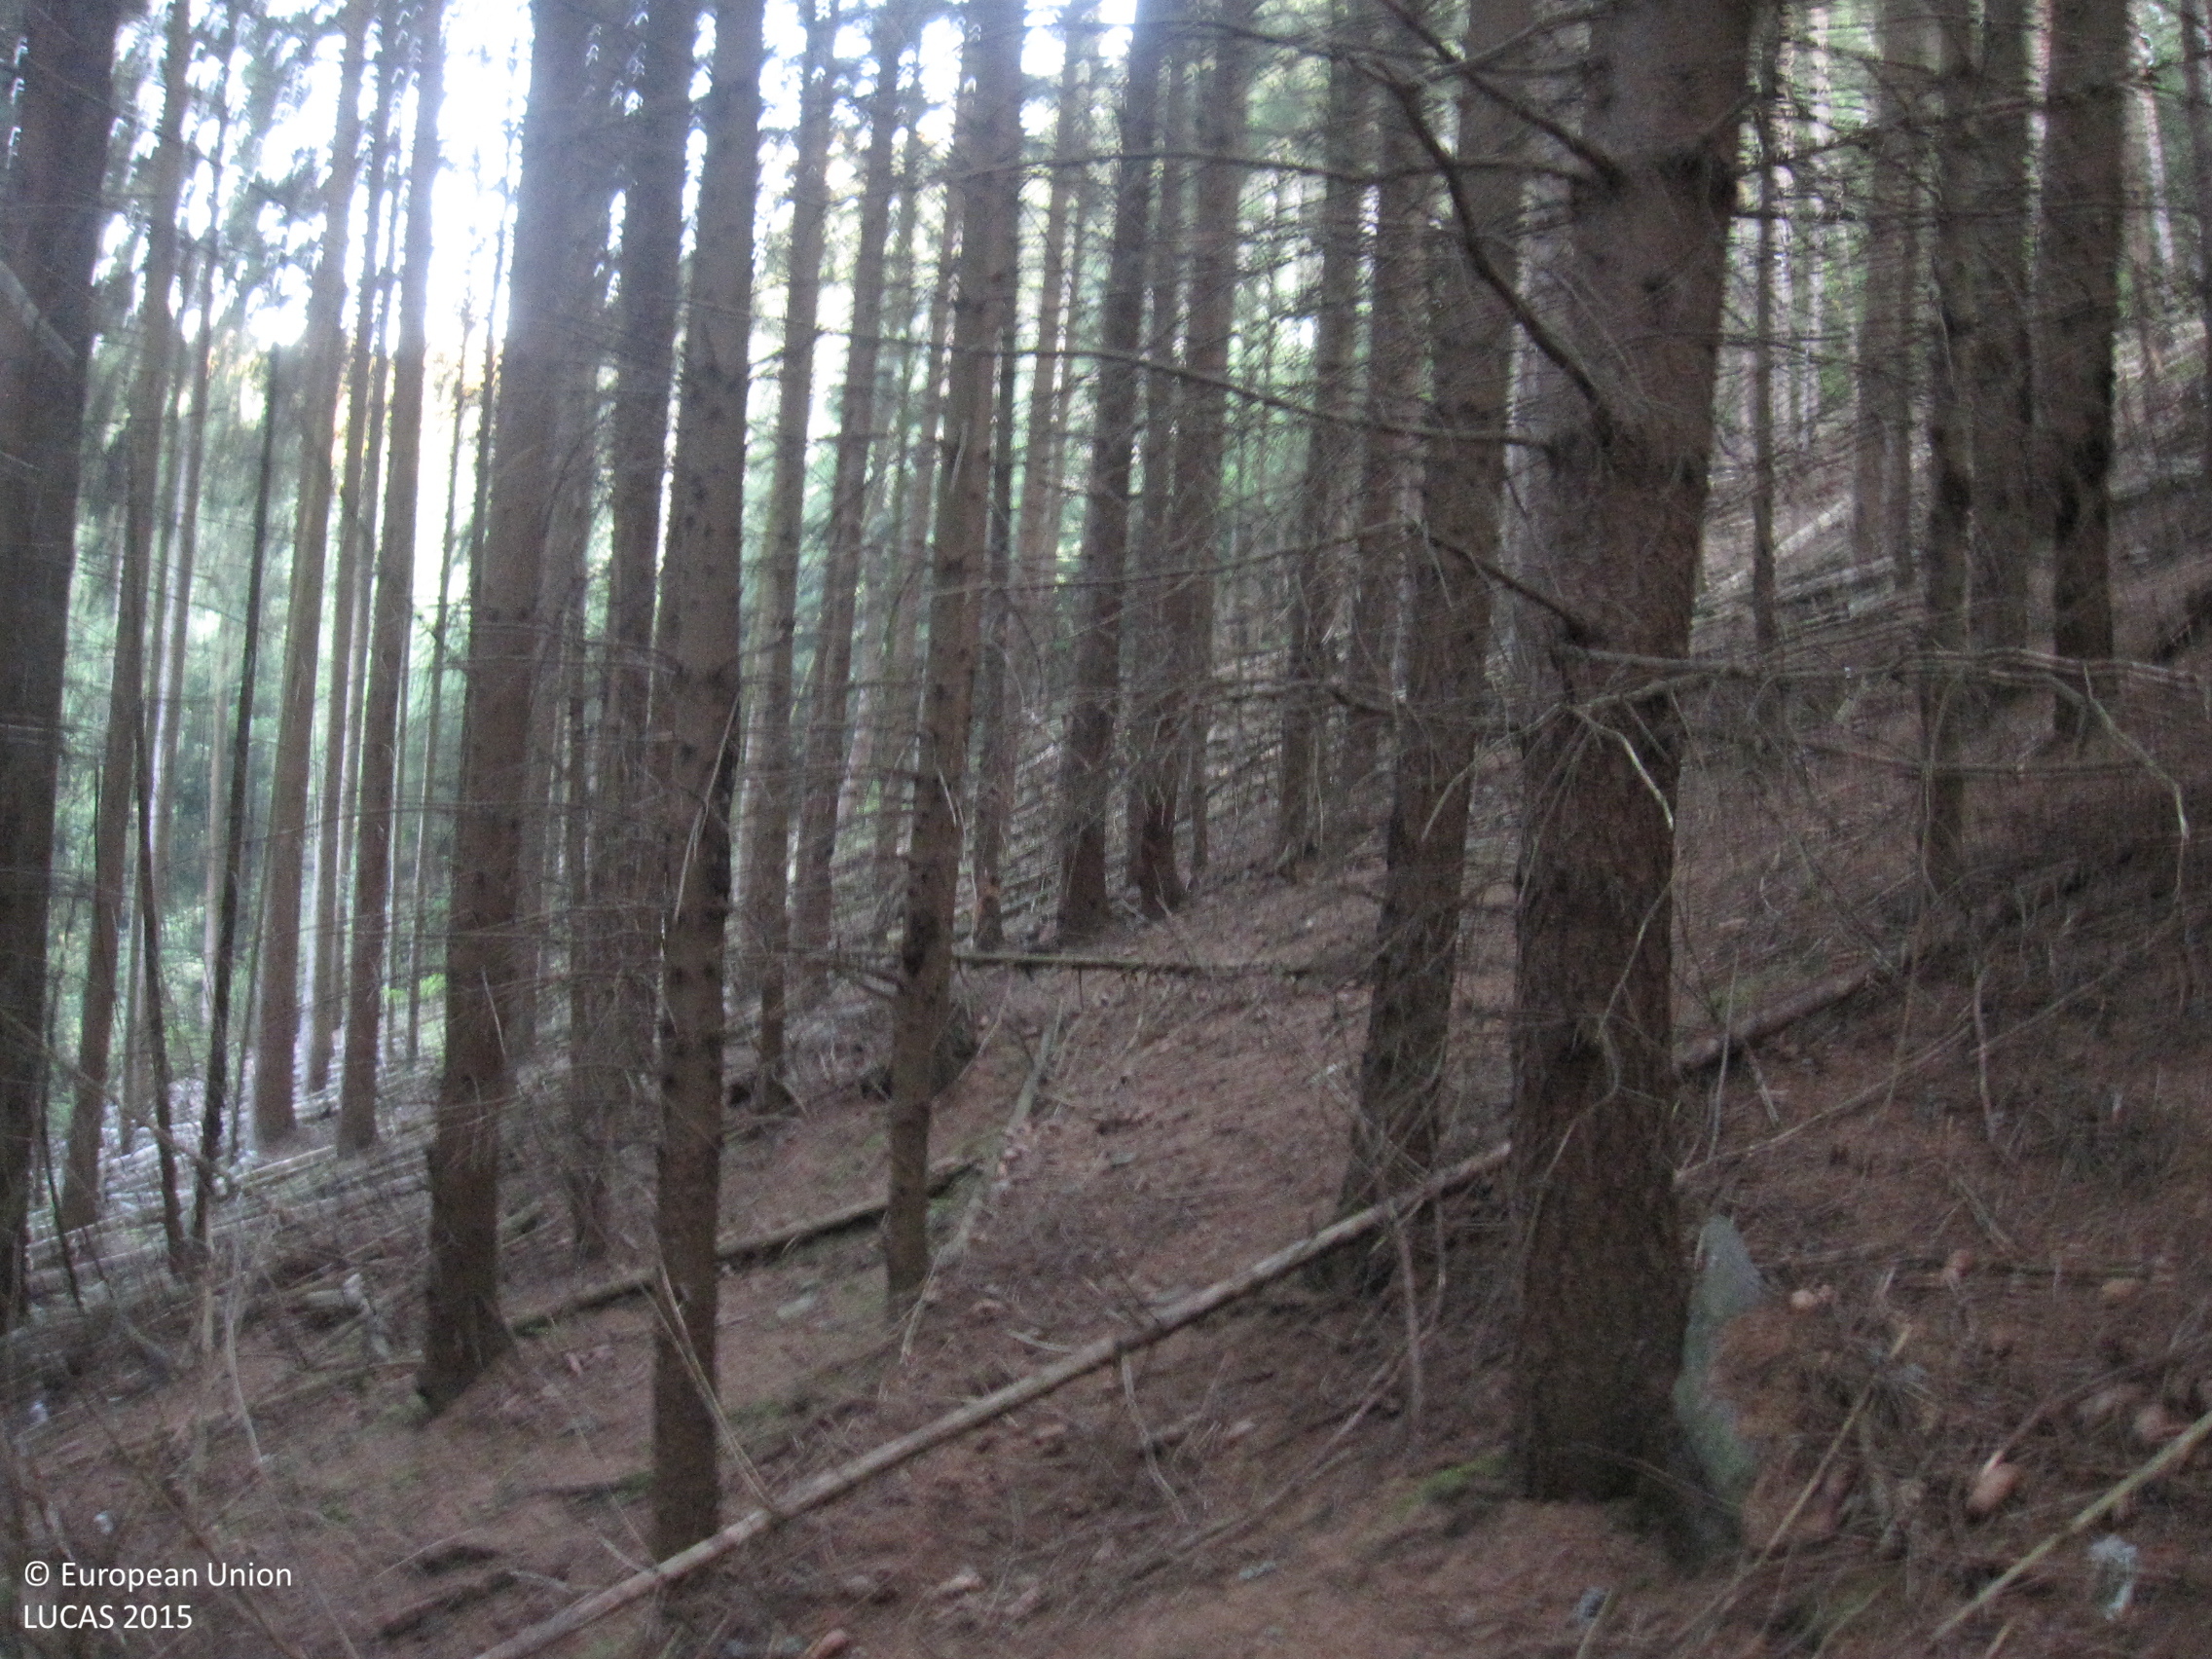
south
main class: Woodland
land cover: Spruce dominated coniferous woodland
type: hemiboreal forest and nemoral coniferous forest and mixed broadleaved-coniferous forest
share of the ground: > 75 %
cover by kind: coniferous forest trees 95 %, unconsolidated bare surface 5 %
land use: Forestry
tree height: > 5 m
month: August
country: DE
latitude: 50.5347
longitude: 11.4528
